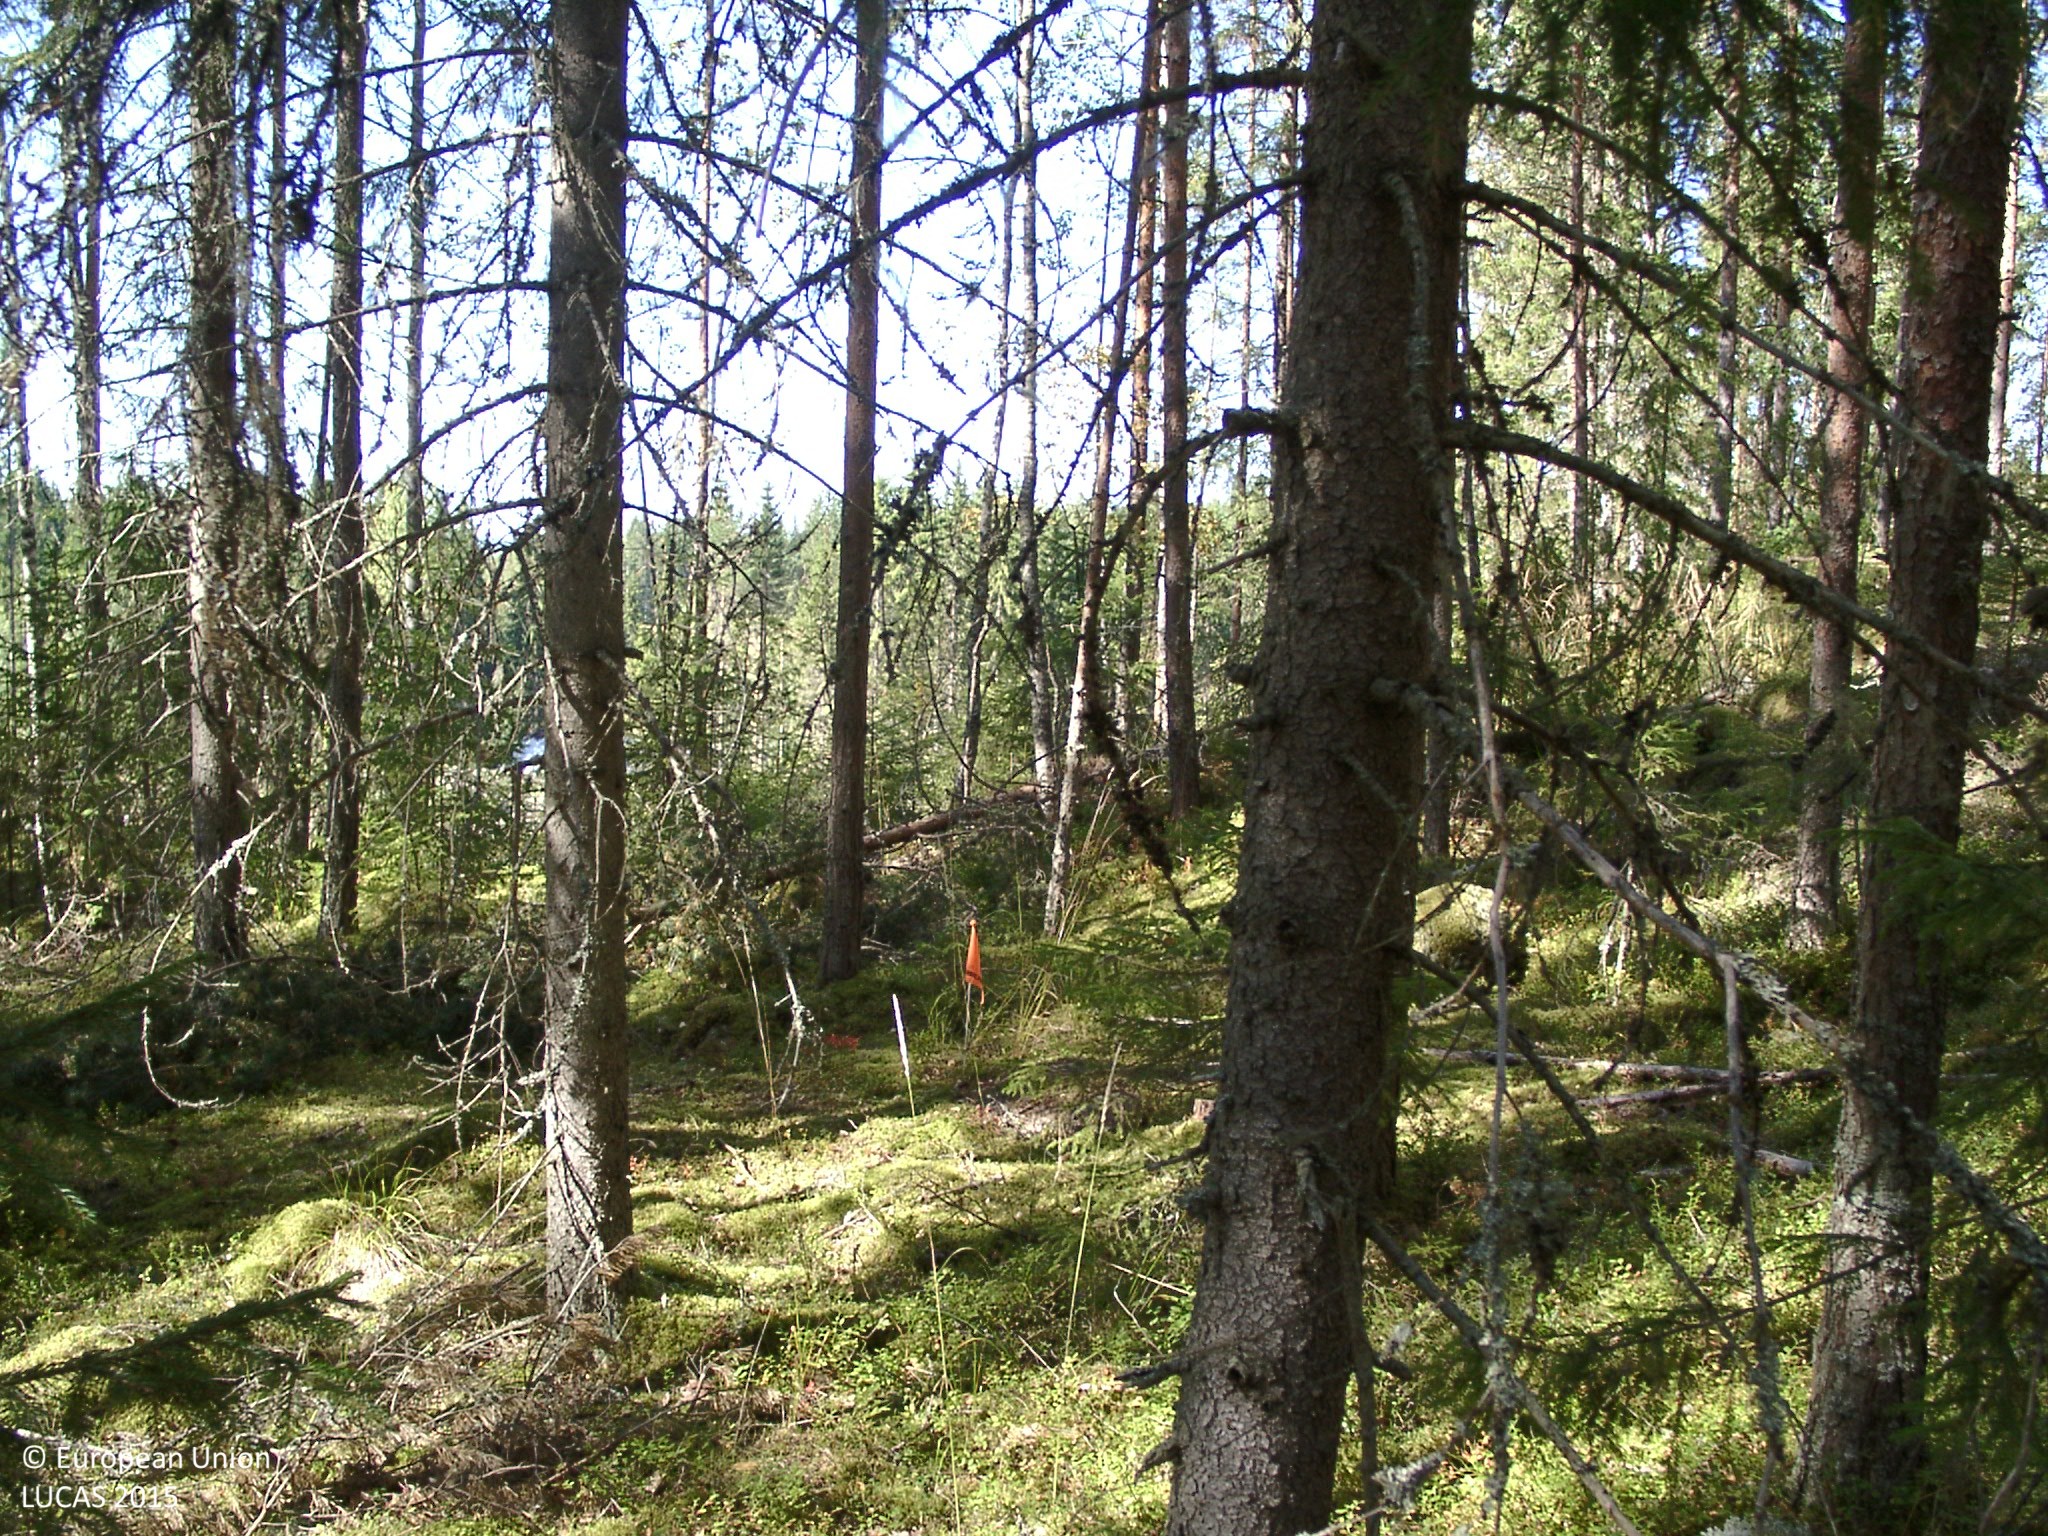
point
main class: Woodland
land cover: Other coniferous woodland
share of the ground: 50 - 75 %
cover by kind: coniferous forest trees 60 %, lichens and mosses 20 %, broadleaved forest trees 10 %, shrubs 10 %
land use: Forestry
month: August
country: FI
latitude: 61.7377
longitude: 25.2389
